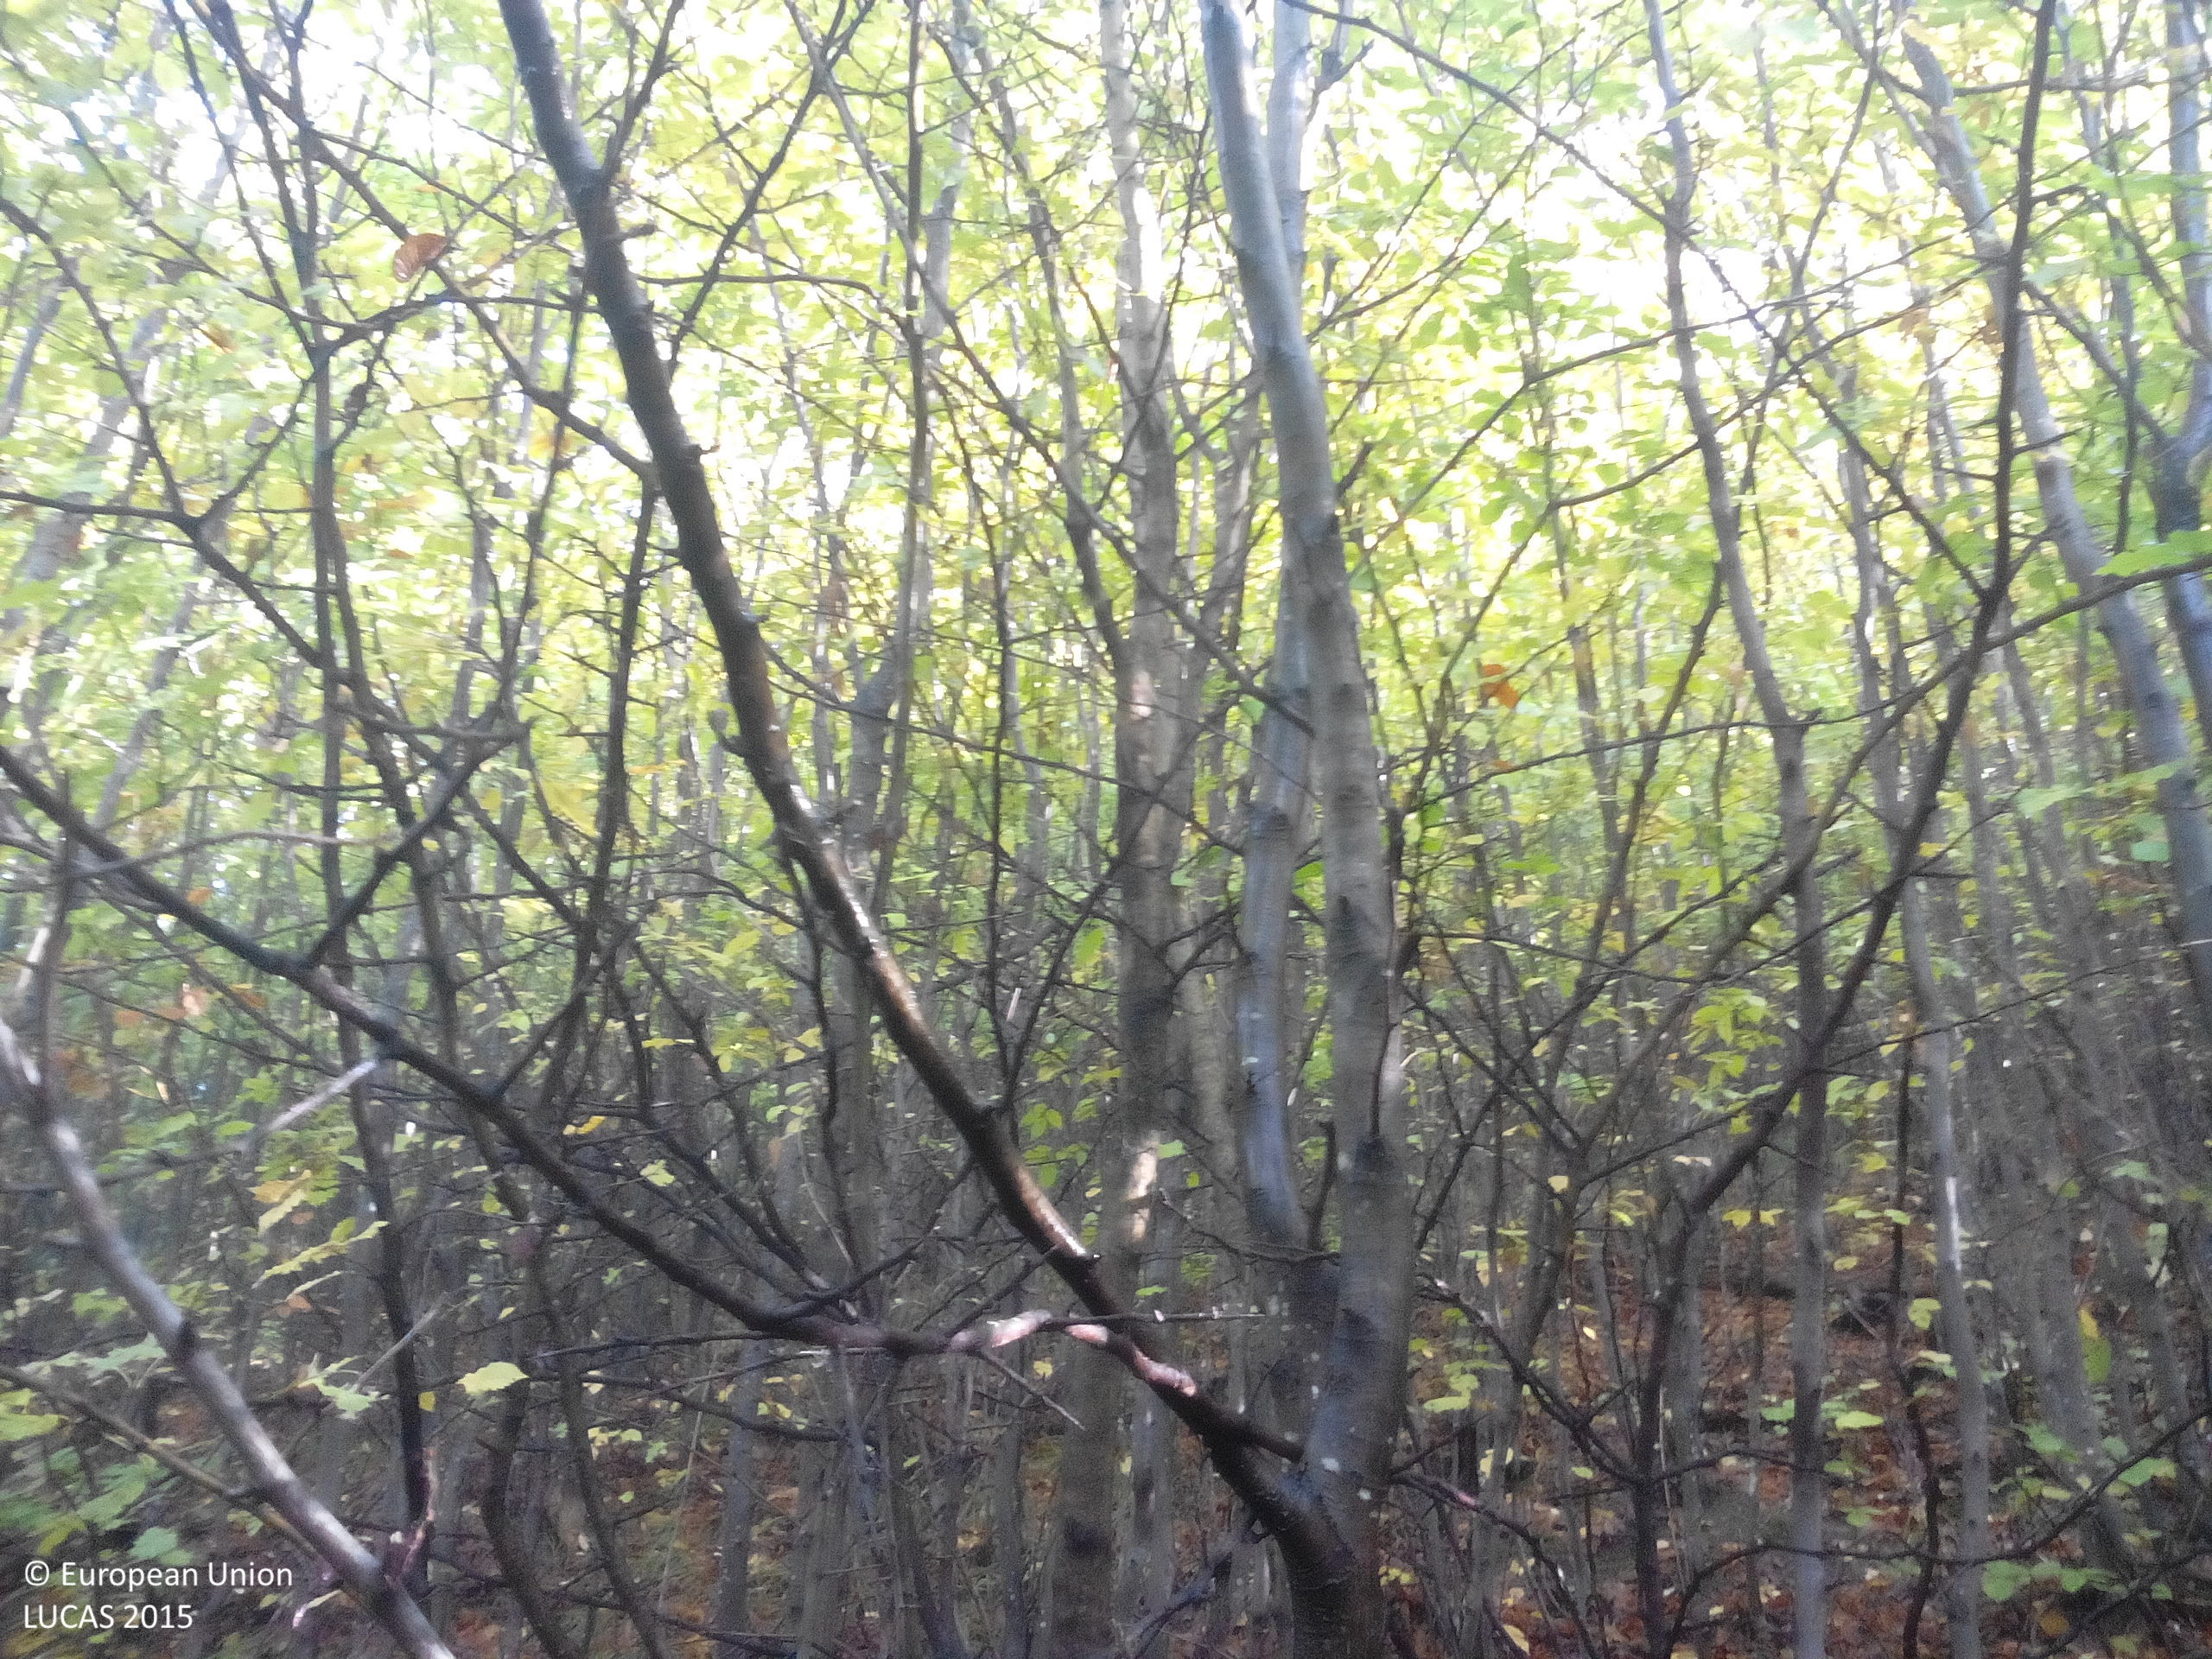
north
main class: Woodland
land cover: Broadleaved woodland
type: beech forest
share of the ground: > 75 %
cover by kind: broadleaved forest trees 95 %, shrubs 5 %
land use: Forestry
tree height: < 5 m
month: October
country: BG
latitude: 42.8174
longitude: 24.7230
